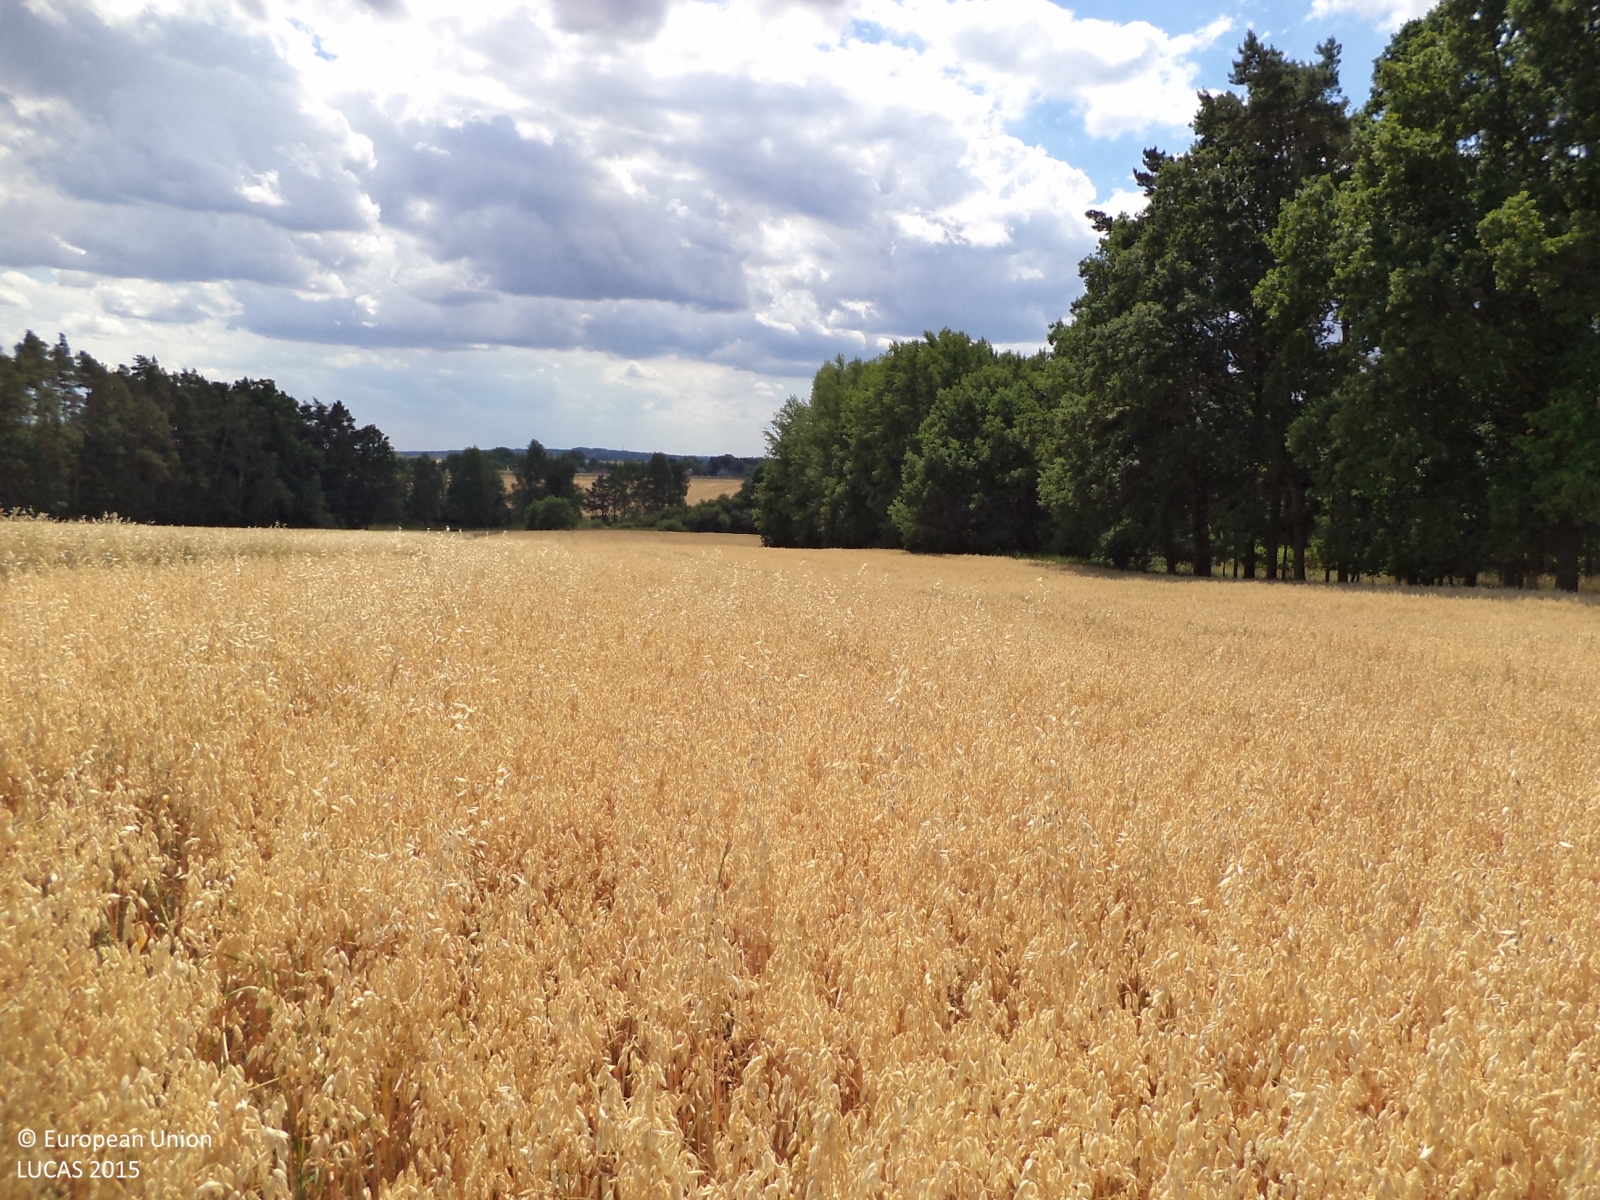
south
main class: Cropland
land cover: Oats
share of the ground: > 75 %
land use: Agriculture (excluding fallow land and kitchen gardens)
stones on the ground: < 10 %
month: July
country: CZ
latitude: 49.4600
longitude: 14.6236
